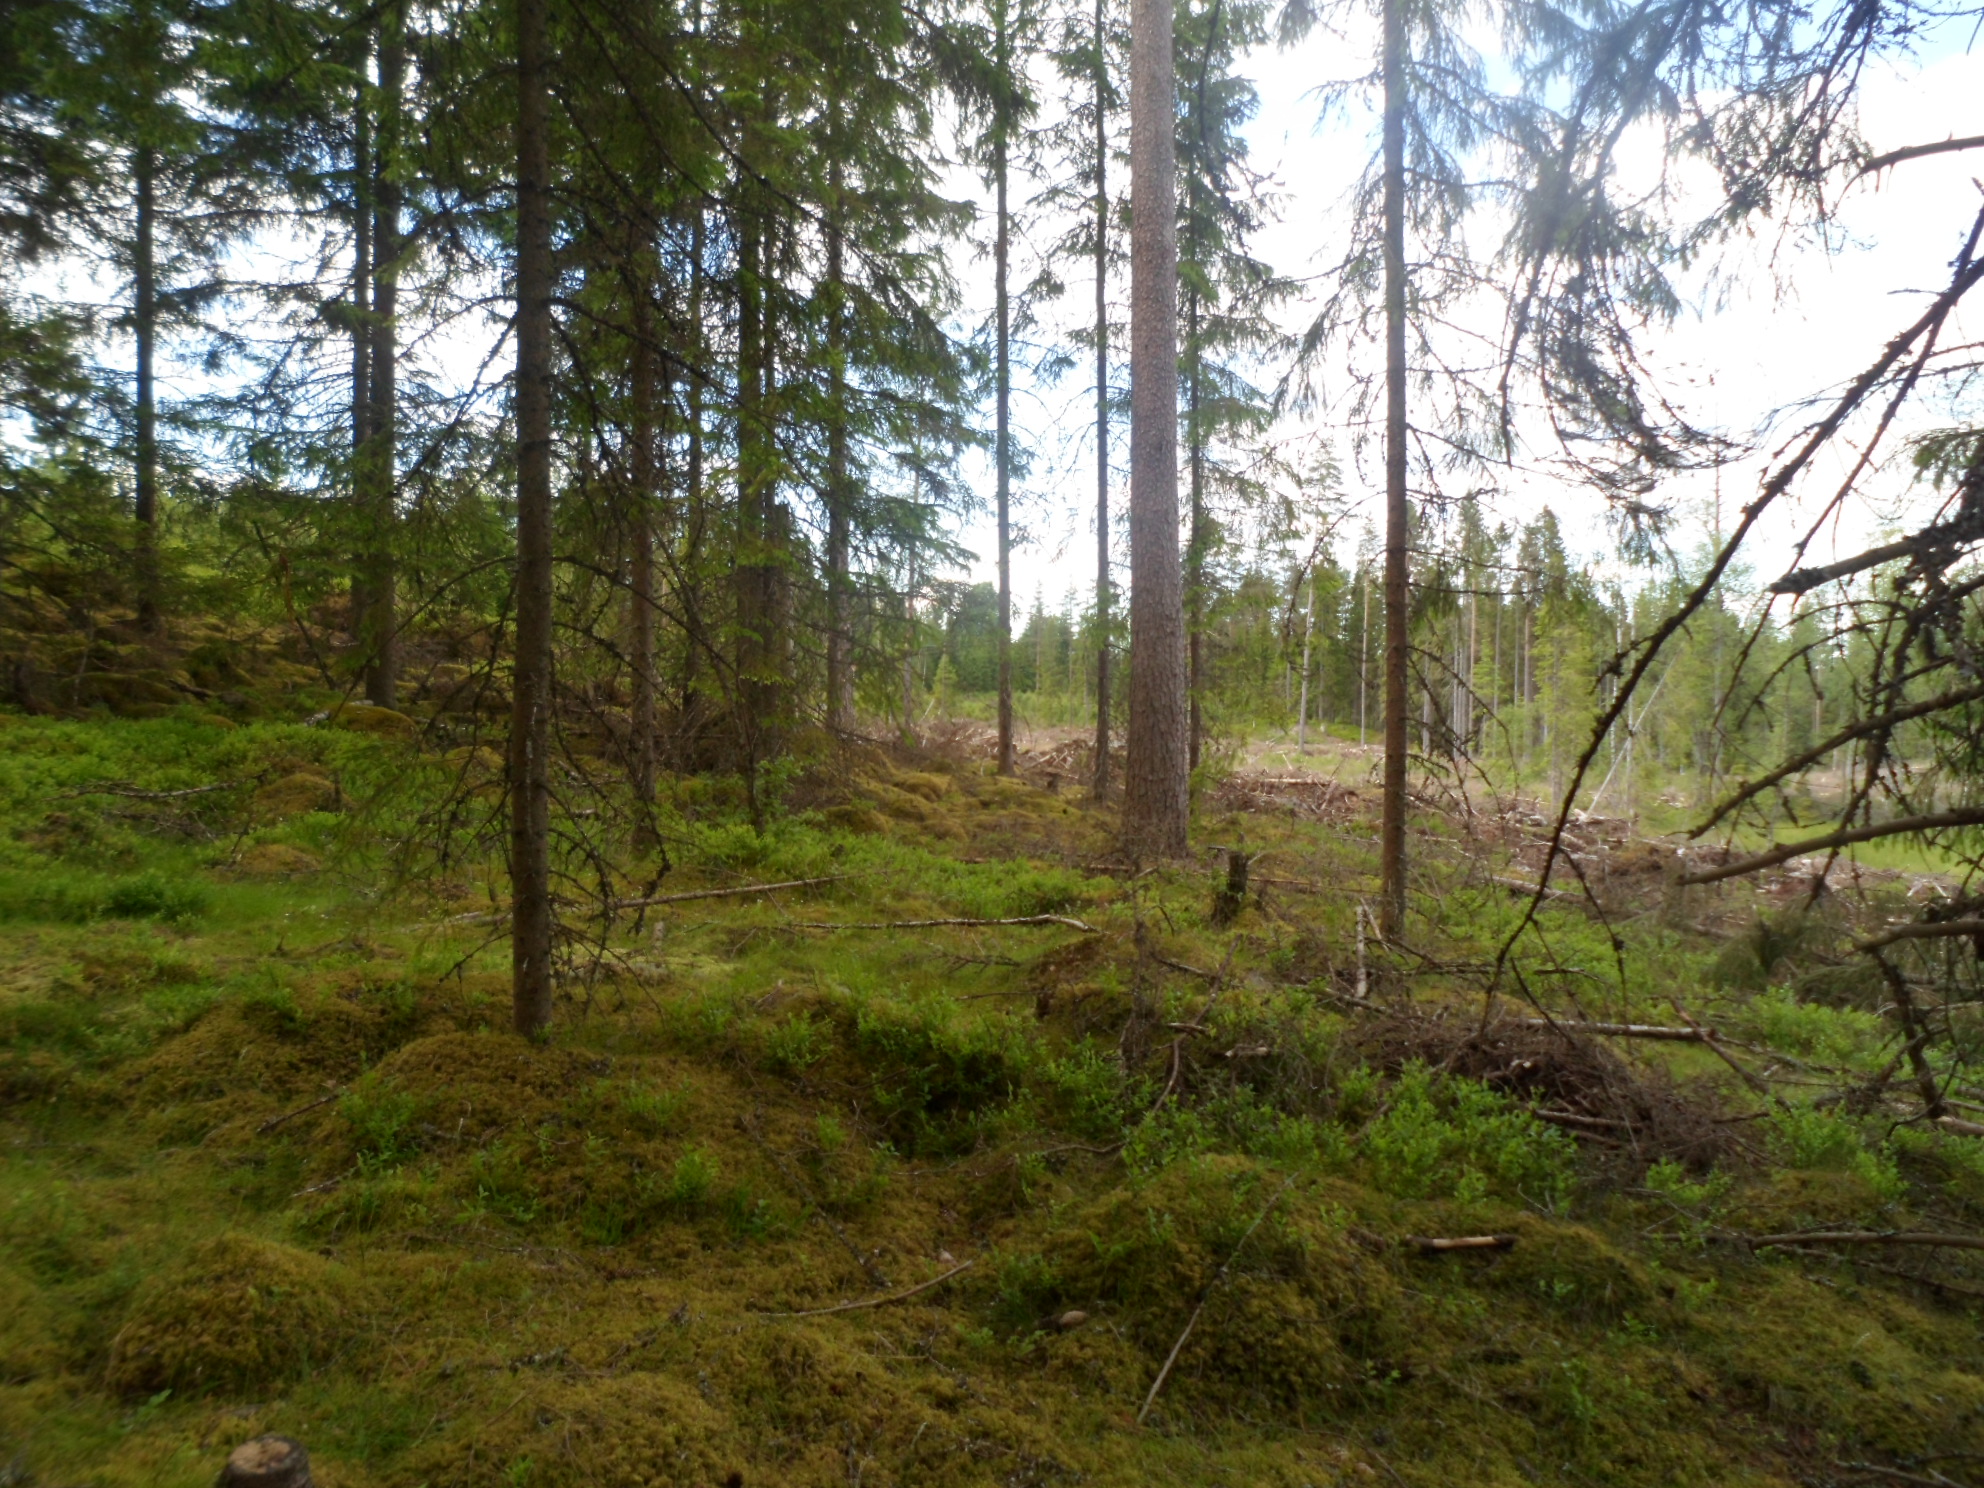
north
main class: Woodland
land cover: Spruce dominated coniferous woodland
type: boreal forest
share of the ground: 50 - 75 %
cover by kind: coniferous forest trees 60 %, shrubs 15 %, lichens and mosses 15 %, broadleaved forest trees 5 %, herbaceous plants 5 %
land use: Forestry
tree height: > 5 m
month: July
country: SE
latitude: 57.5354
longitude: 14.3885
